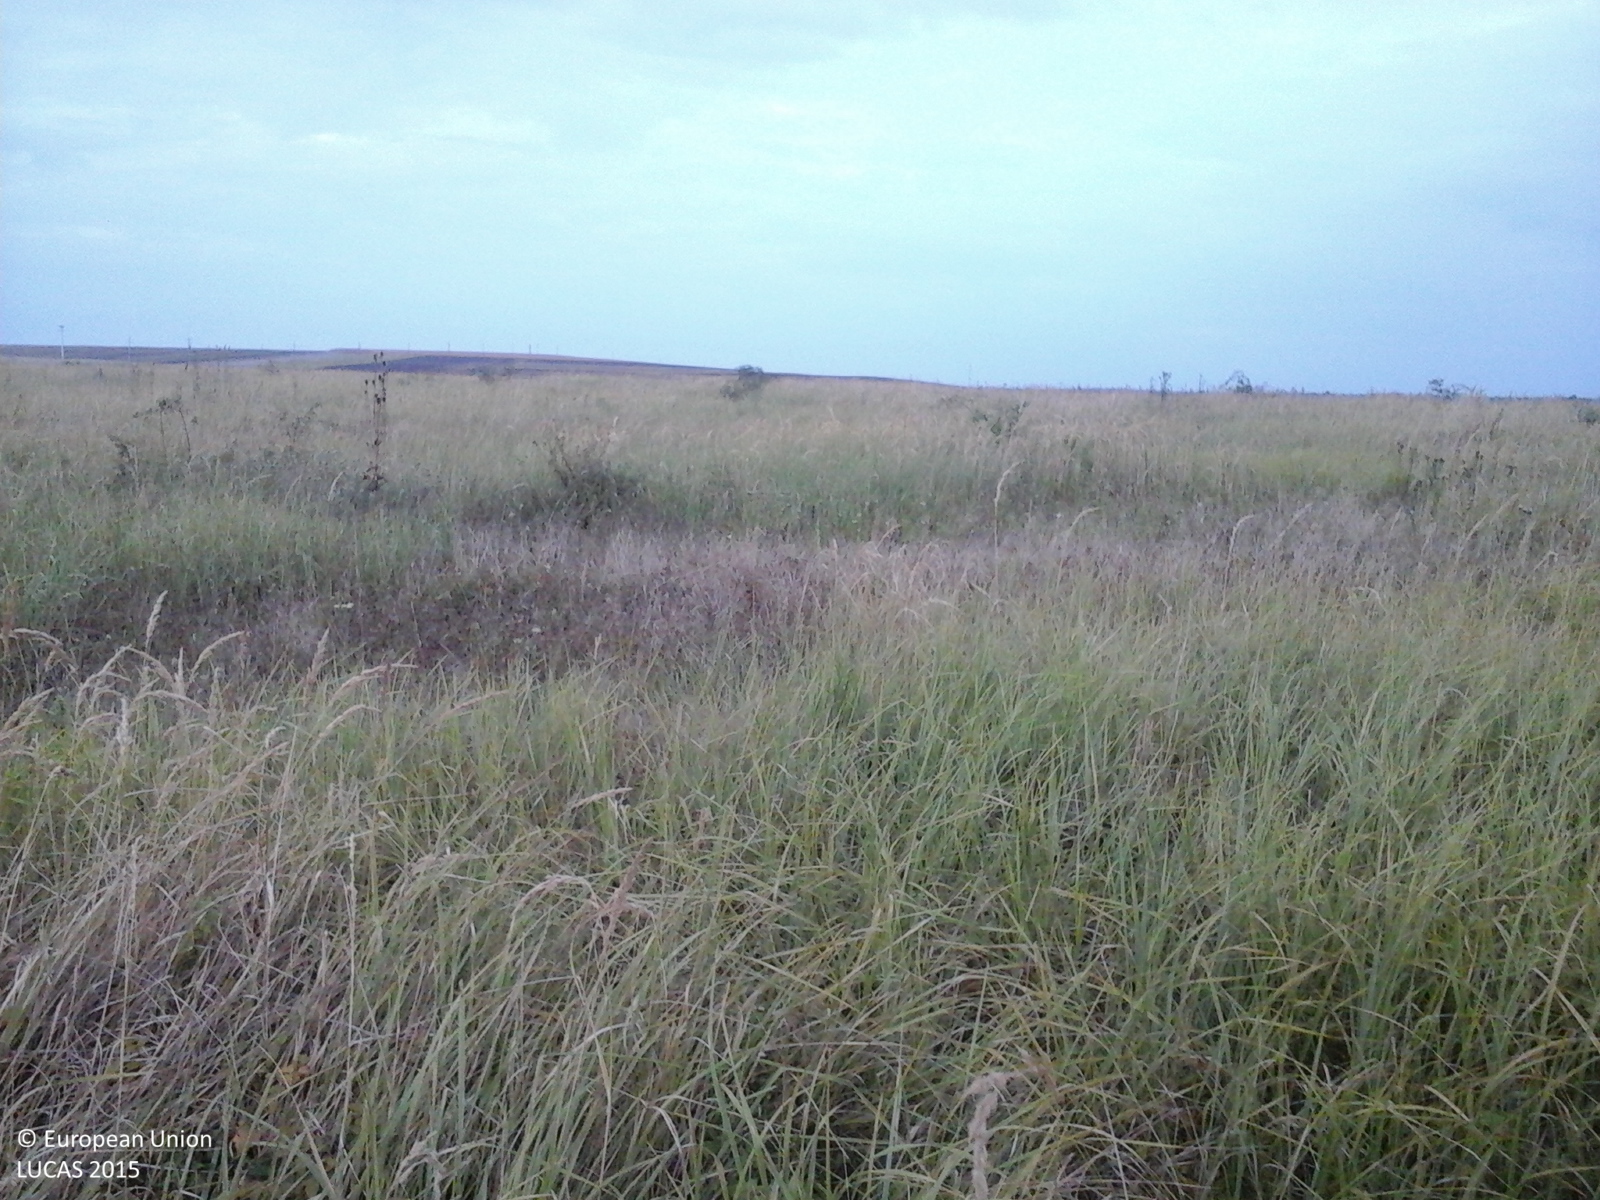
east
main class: Grassland
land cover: Spontaneously vegetated surfaces
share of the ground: > 75 %
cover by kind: herbaceous plants 100 %
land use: Fallow land
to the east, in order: Spontaneously vegetated surfaces; Sunflower
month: August
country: RO
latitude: 45.7961
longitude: 21.5490
